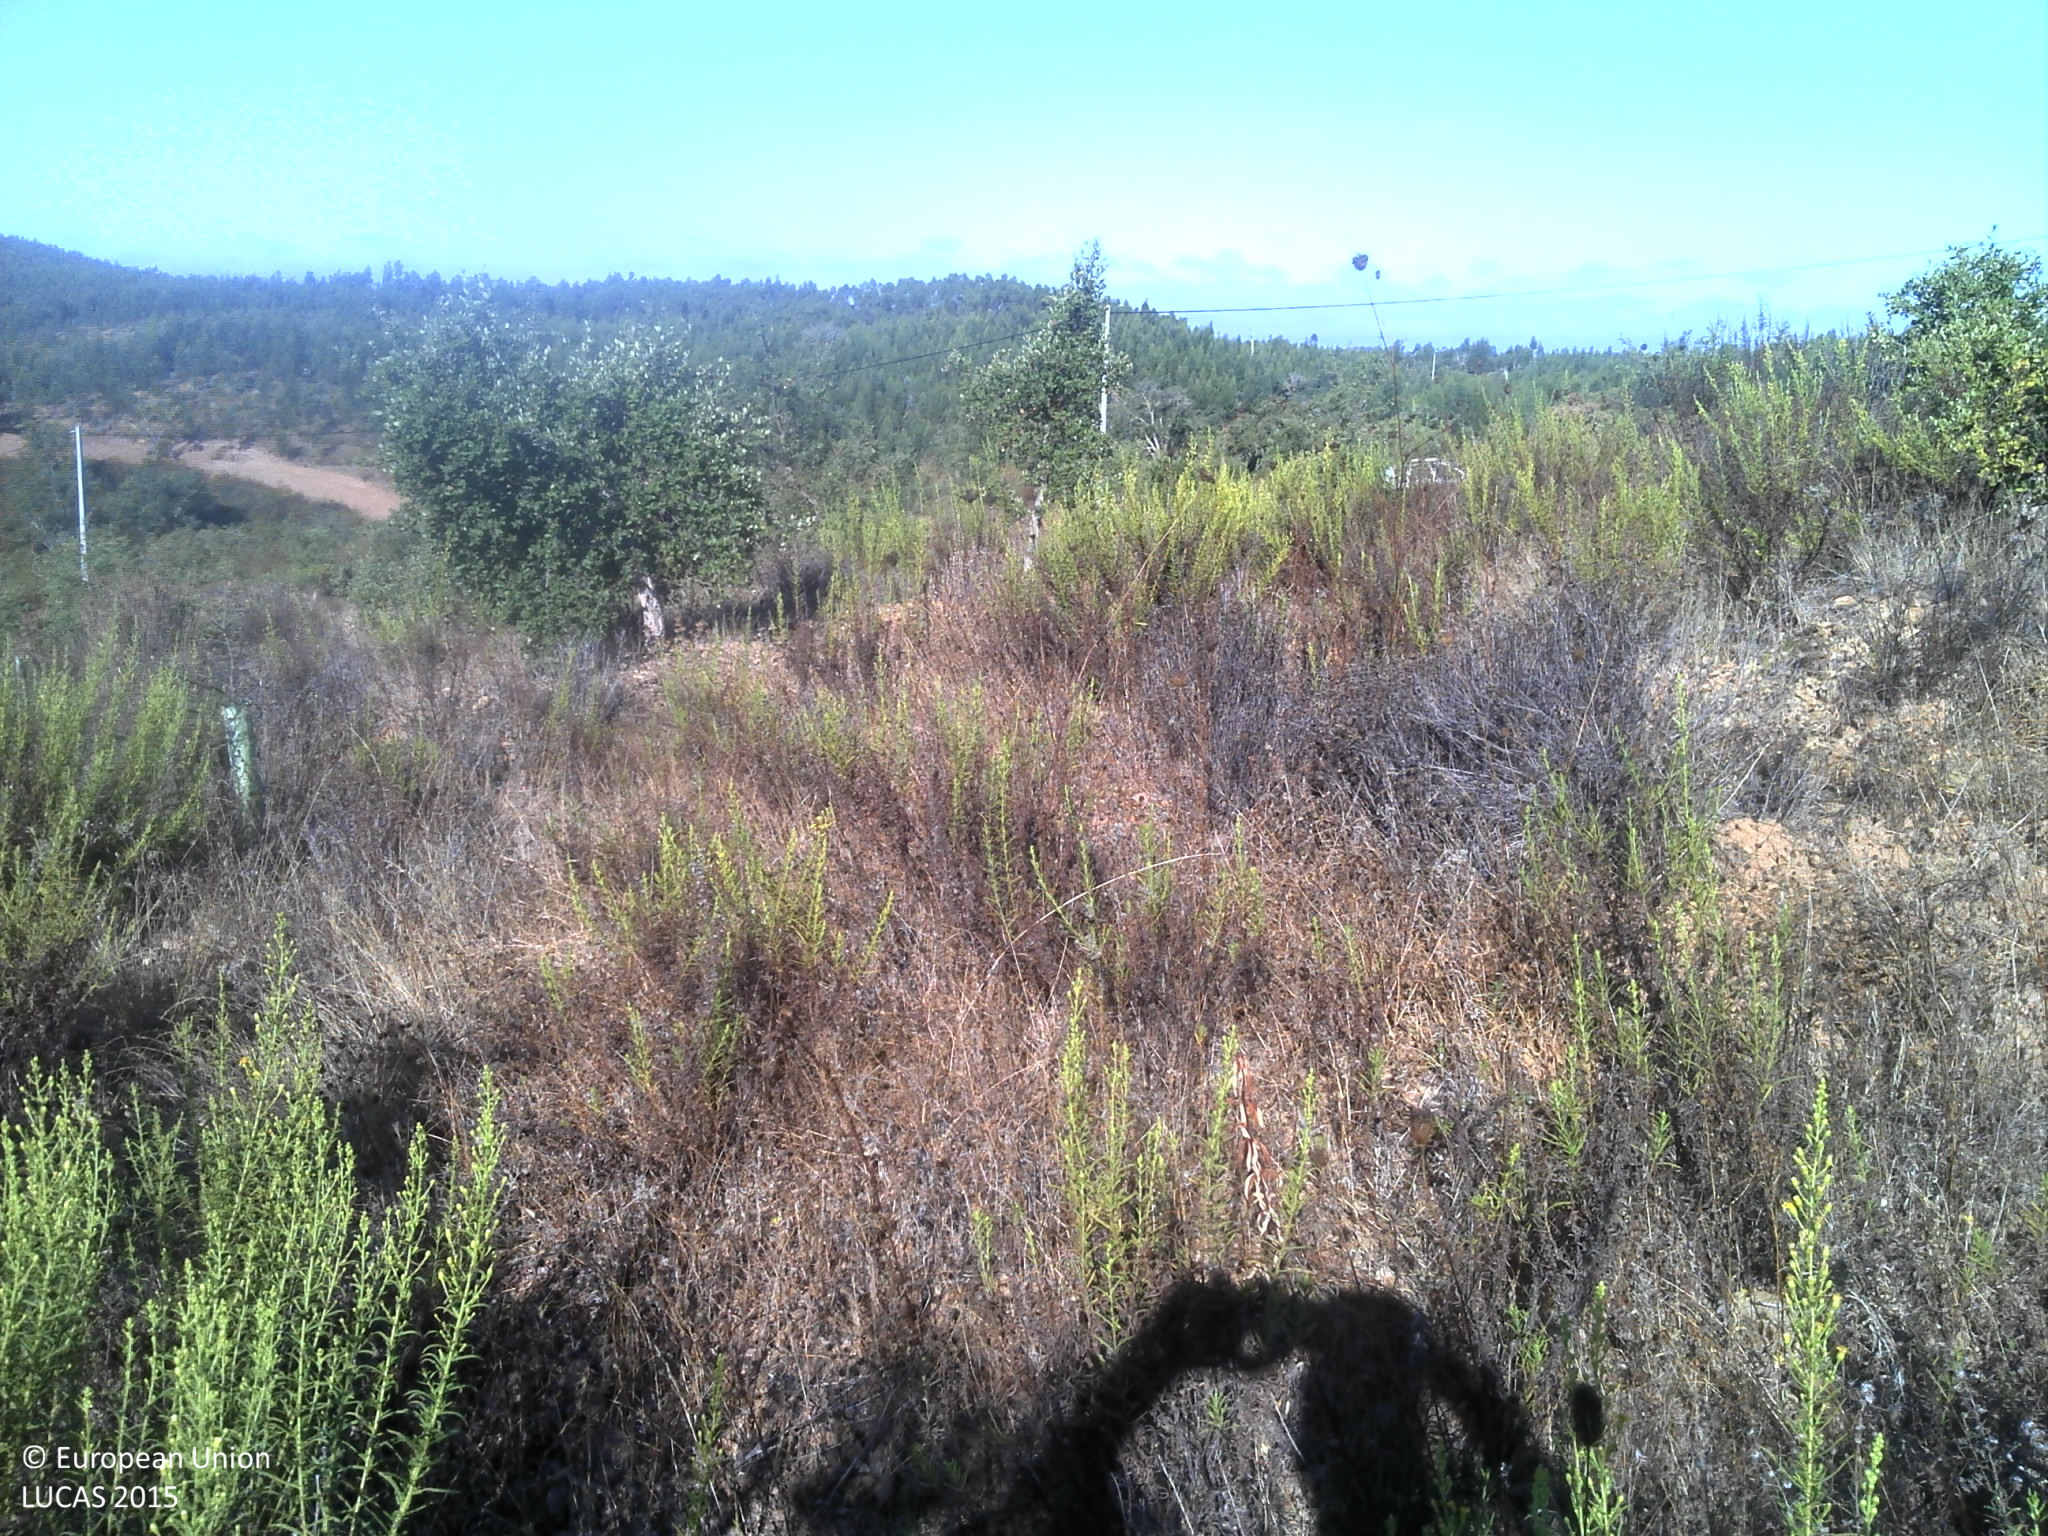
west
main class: Woodland
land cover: Broadleaved woodland
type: broadleaved evergreen forest
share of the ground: 10 - 25 %
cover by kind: shrubs 40 %, unconsolidated bare surface 35 %, broadleaved forest trees 25 %
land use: Forestry
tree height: < 5 m
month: August
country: PT
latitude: 37.5912
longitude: -8.4597
